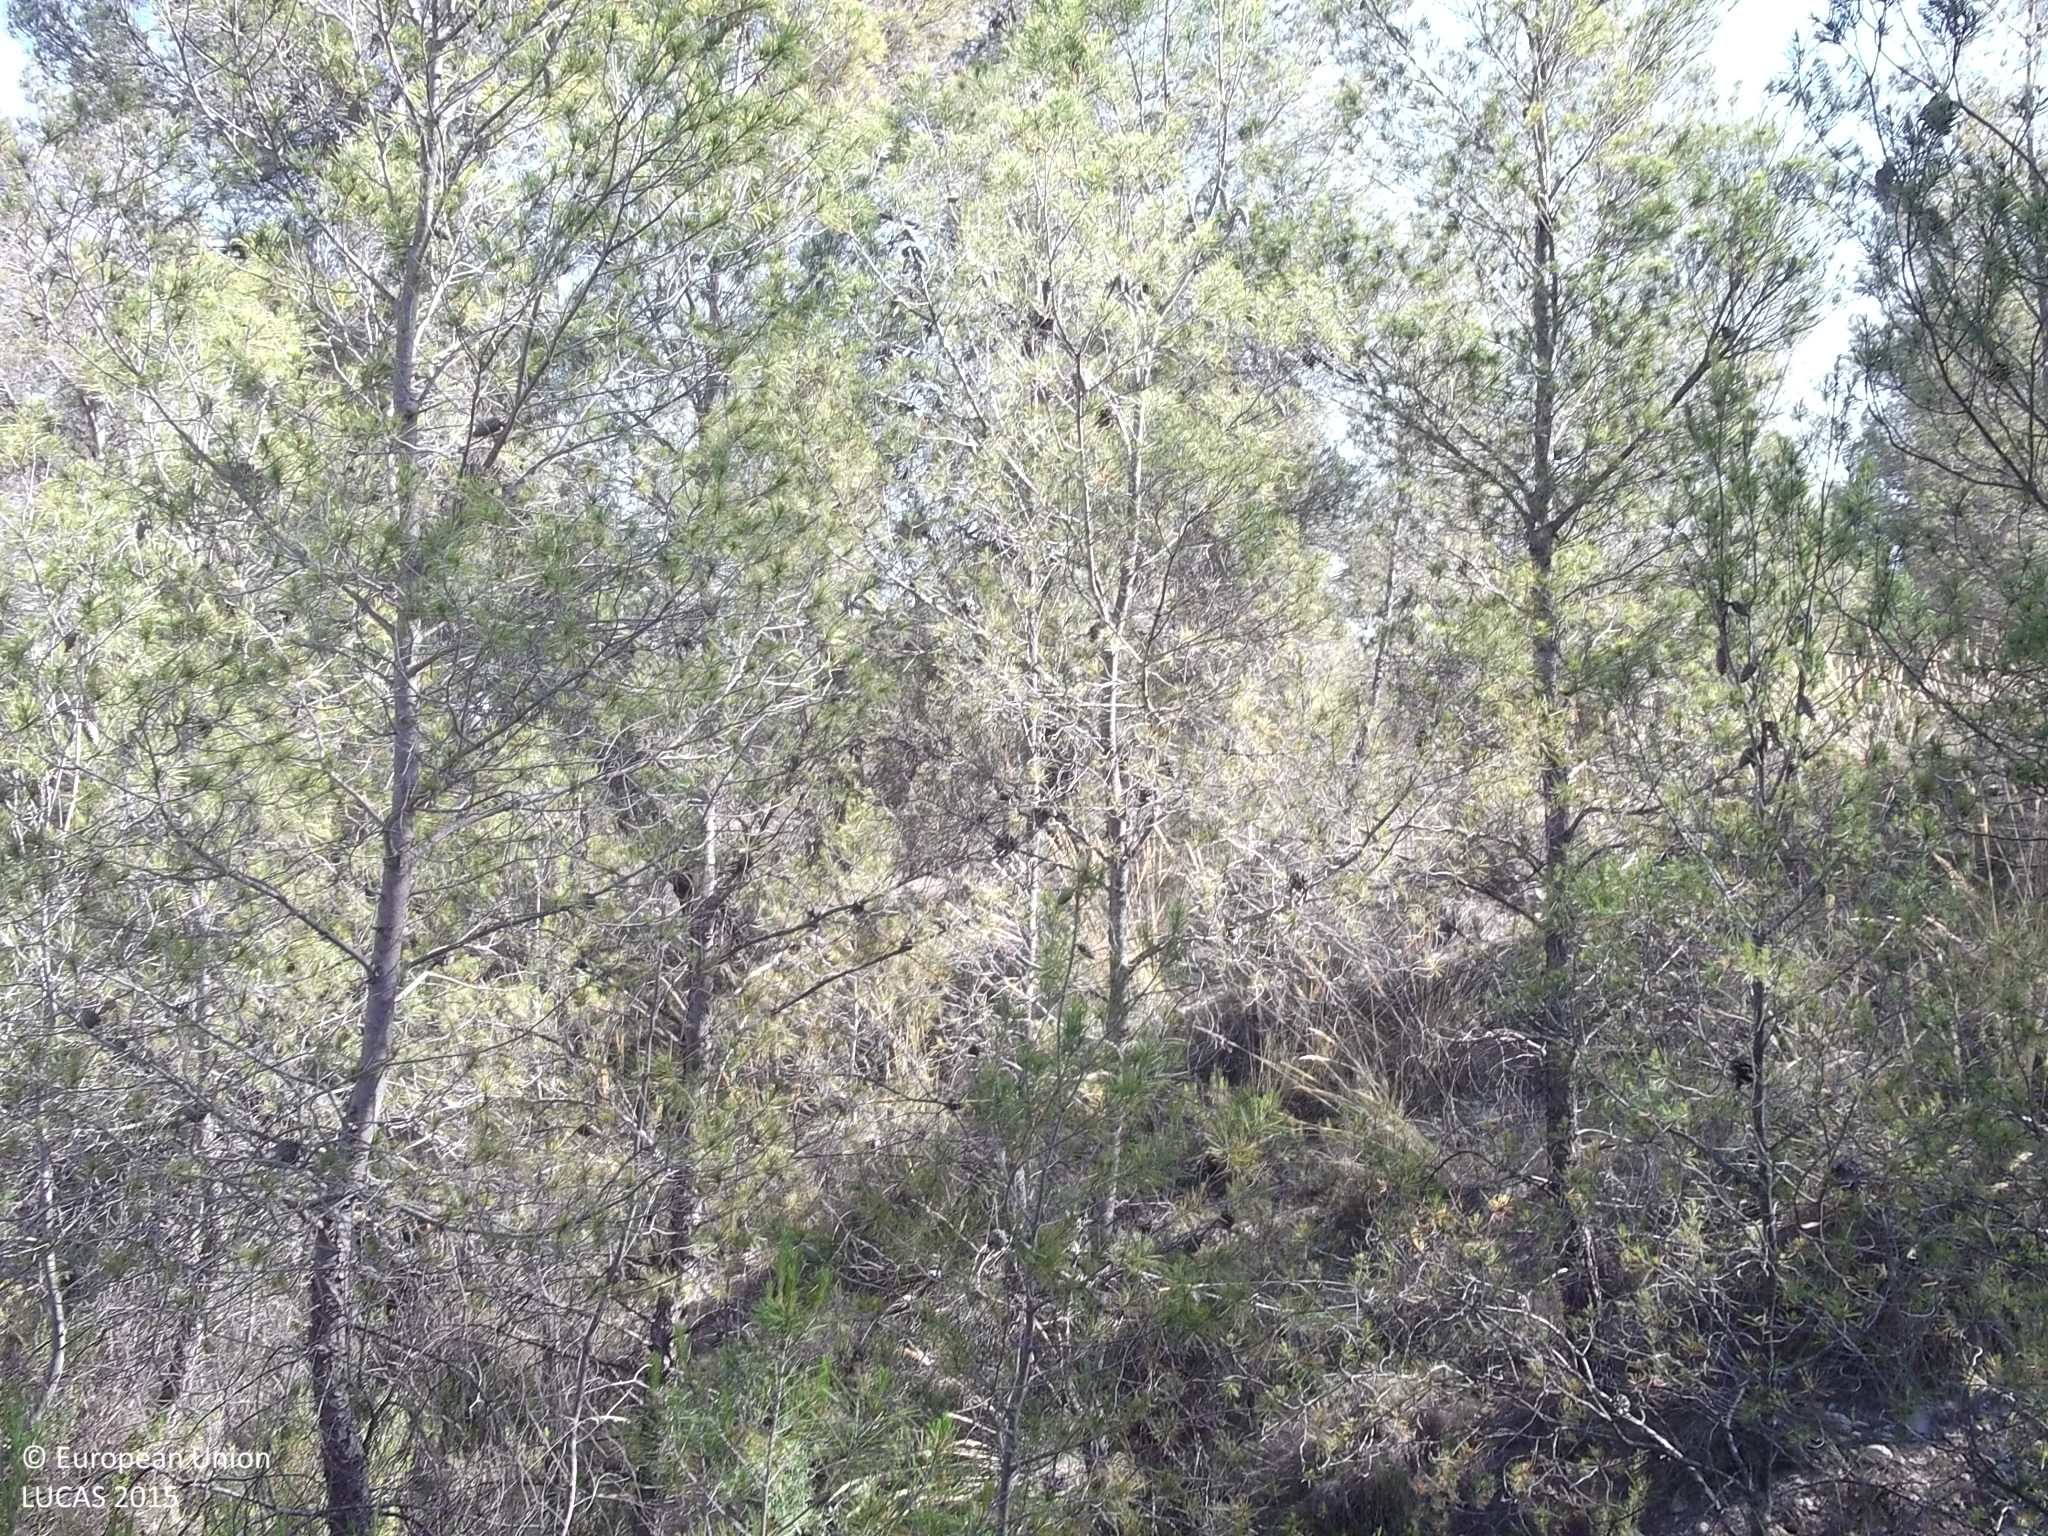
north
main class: Woodland
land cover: Pine dominated coniferous woodland
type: coniferous forest of the mediterranean region
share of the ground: 50 - 75 %
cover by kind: coniferous forest trees 50 %, shrubs 30 %, herbaceous plants 20 %
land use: Forestry
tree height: > 5 m
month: June
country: ES
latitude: 38.2015
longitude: -1.4875
